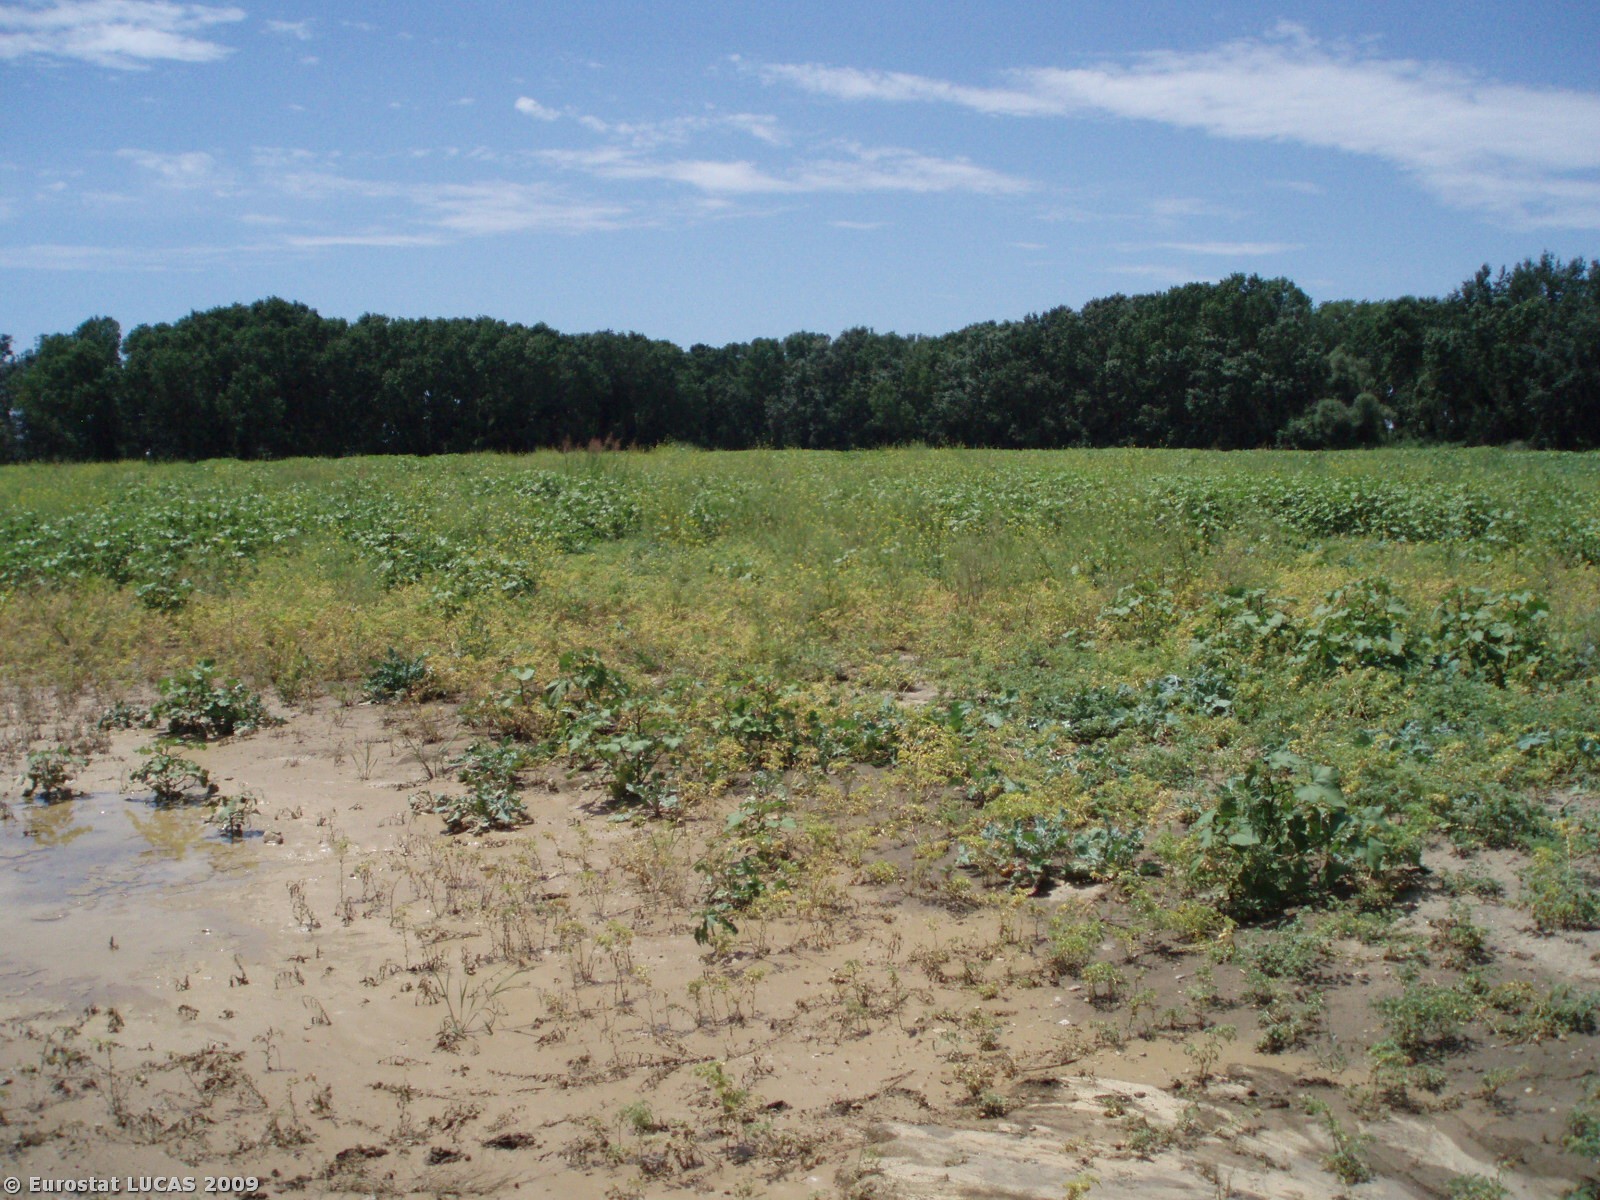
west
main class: Cropland
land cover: Sunflower
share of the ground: > 75 %
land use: Agriculture (excluding fallow land and kitchen gardens)
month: June
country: IT
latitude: 42.3526
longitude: 11.5848
